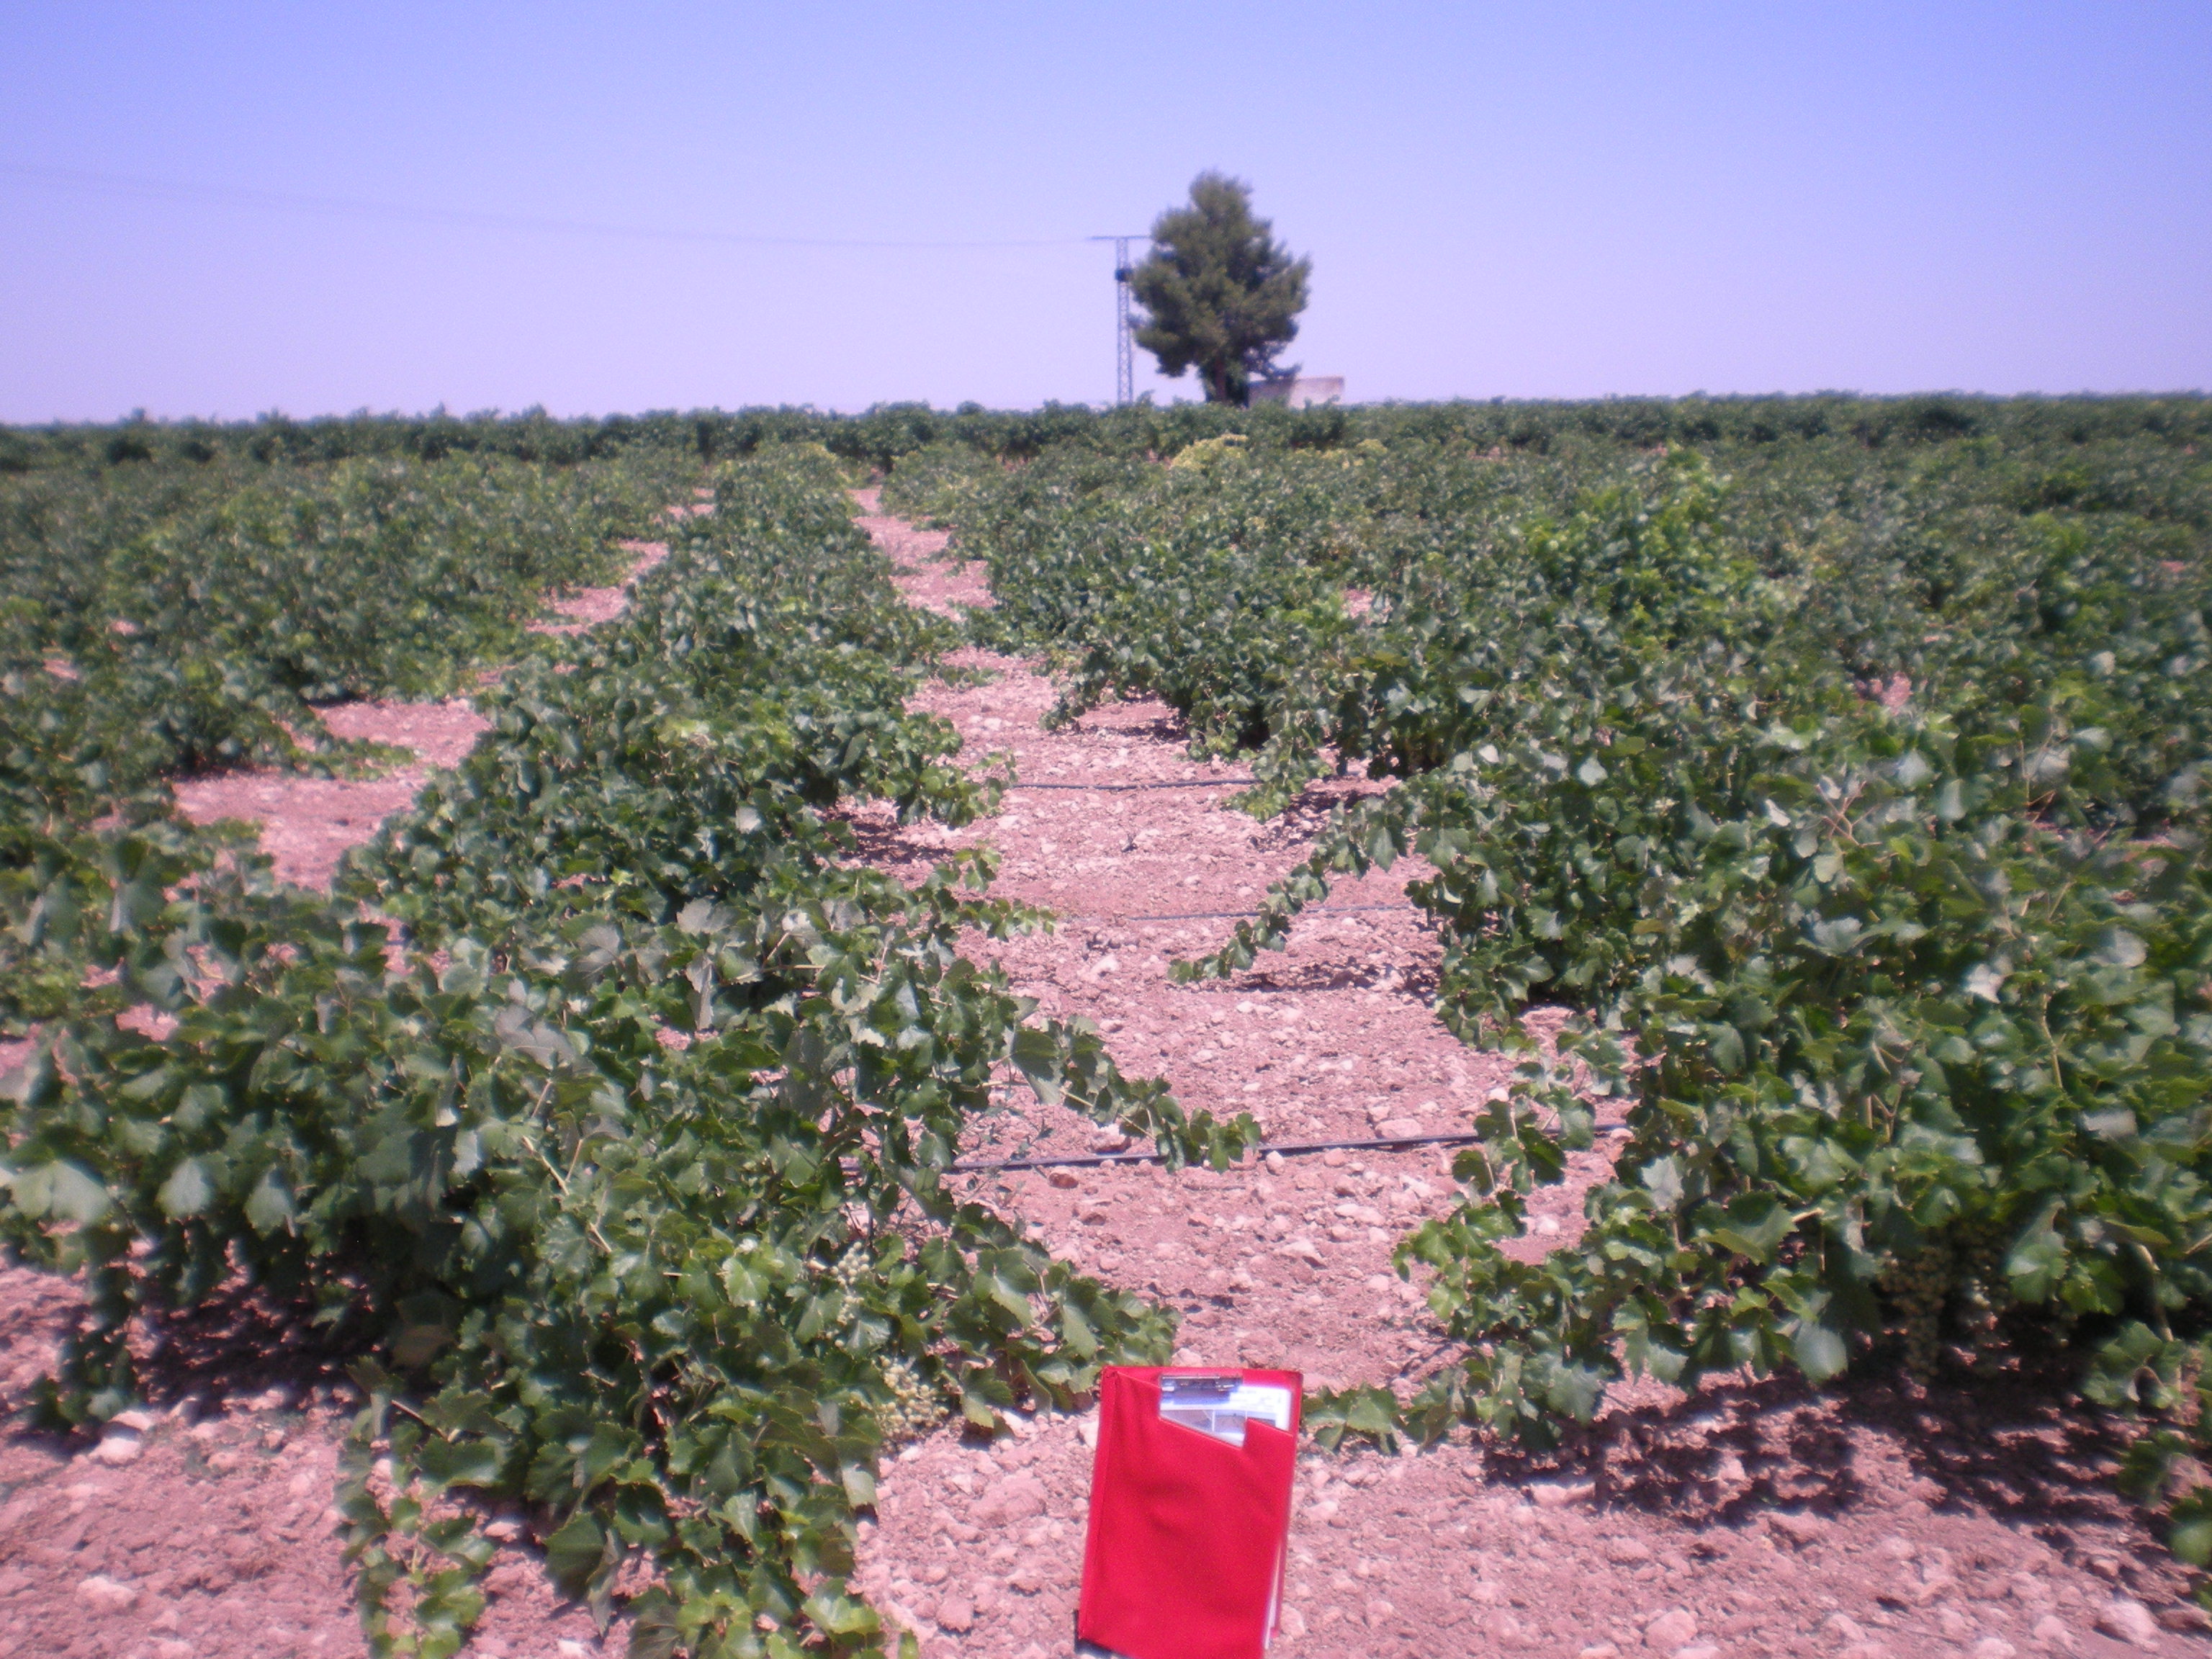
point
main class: Cropland
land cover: Vineyards
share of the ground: 25 - 50 %
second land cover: Other bare soil
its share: > 75 %
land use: Agriculture (excluding fallow land and kitchen gardens)
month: July
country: ES
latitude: 39.2569
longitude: -3.0985
